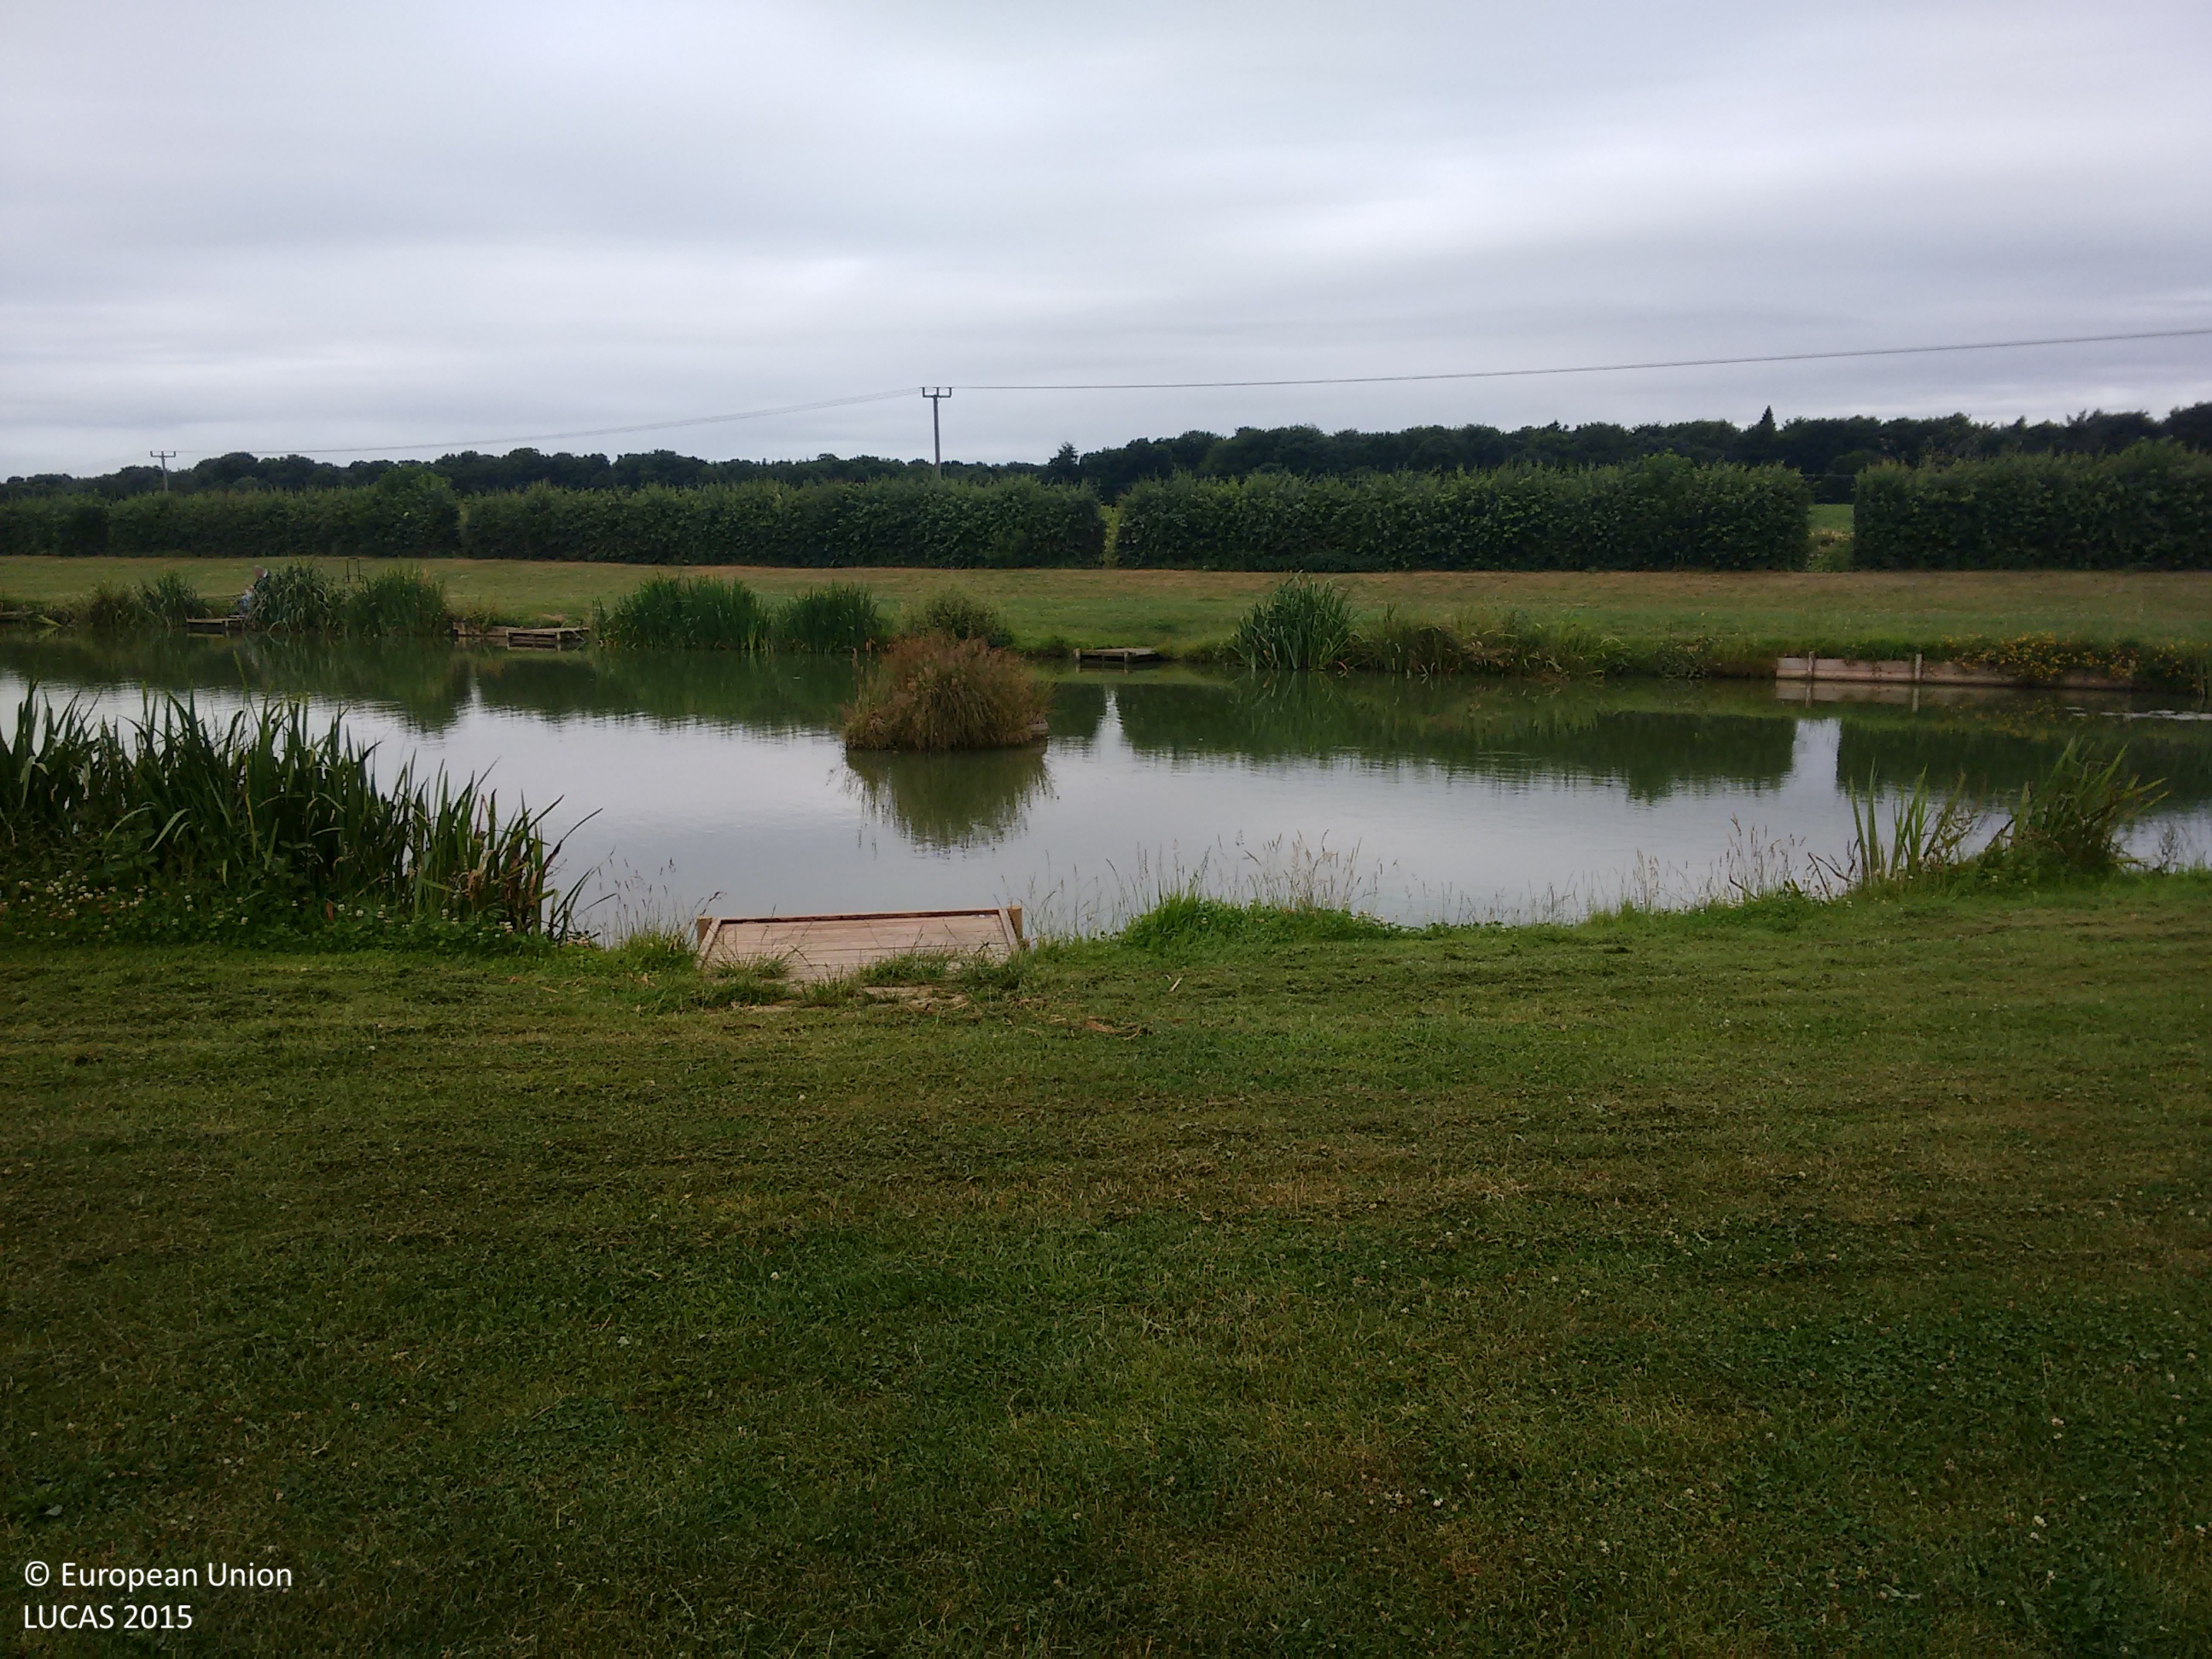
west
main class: Grassland
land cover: Grassland without tree/shrub cover
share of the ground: > 75 %
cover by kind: herbaceous plants 100 %
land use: Amenities, museums, leisure
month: July
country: GB
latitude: 53.2060
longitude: -1.0184
